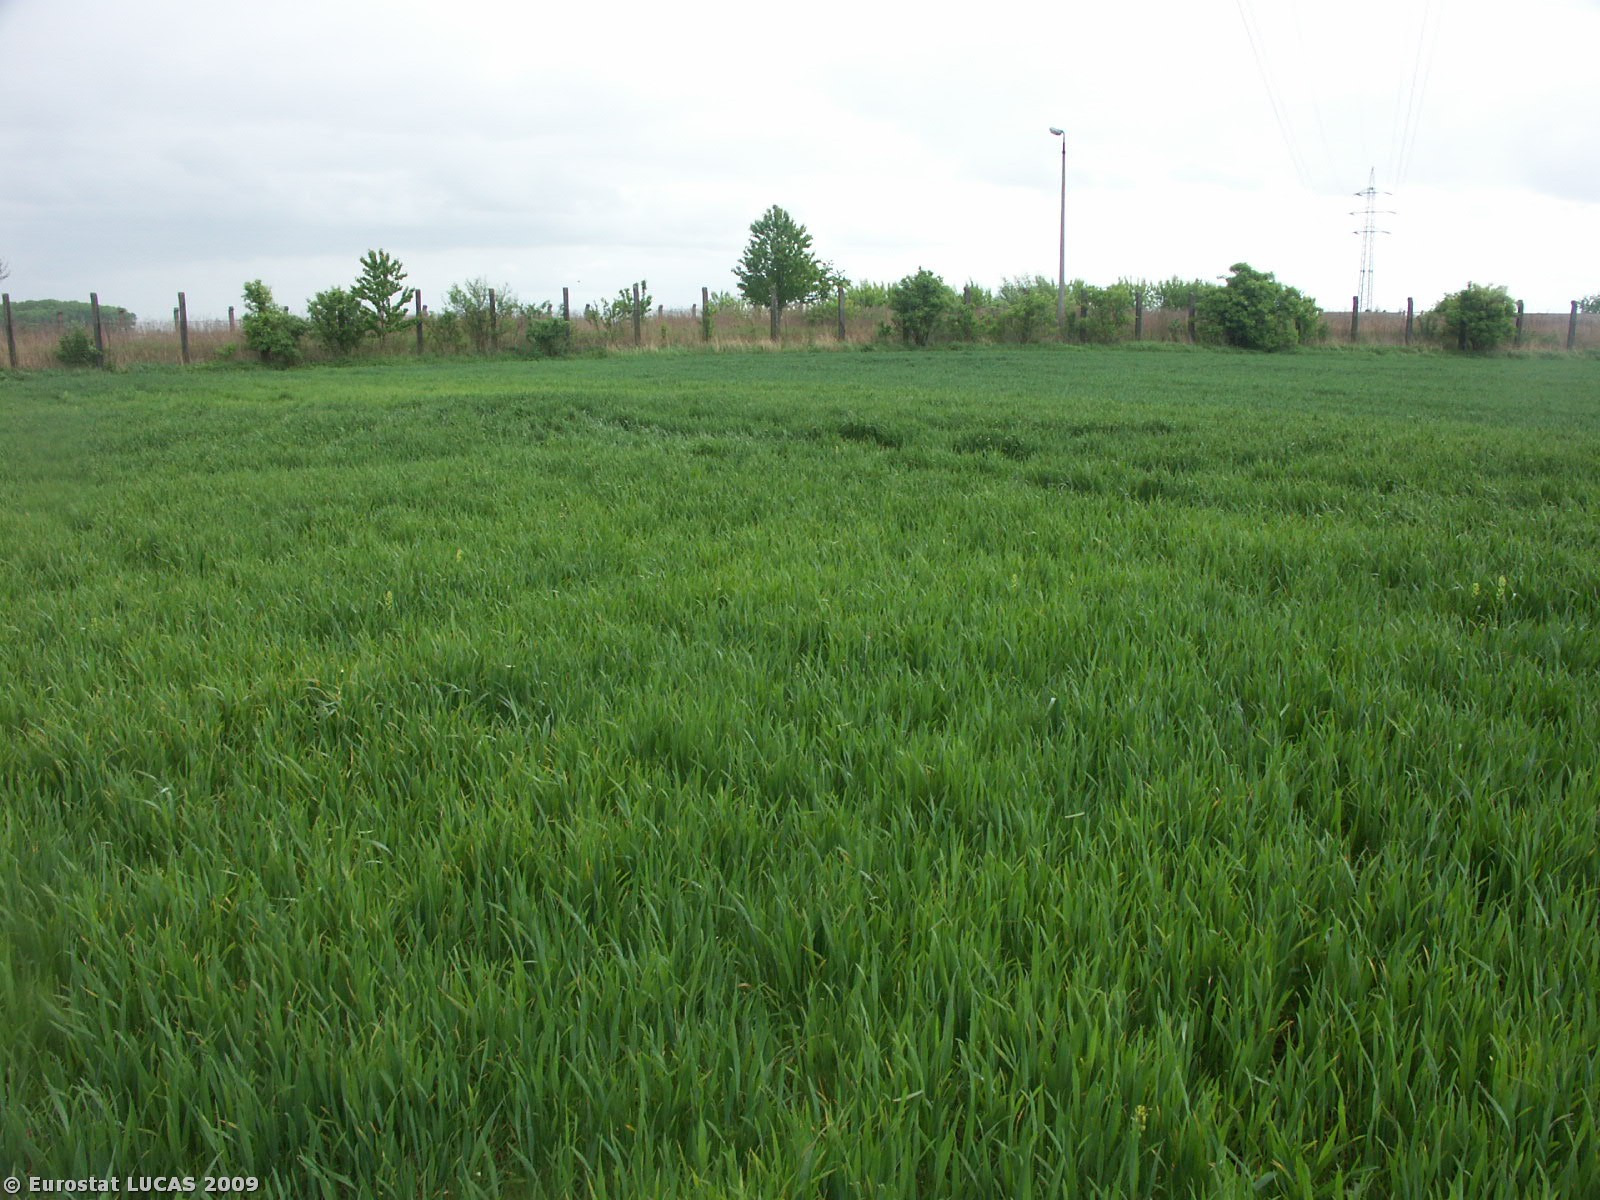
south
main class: Cropland
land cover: Common wheat
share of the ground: > 75 %
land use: Agriculture (excluding fallow land and kitchen gardens)
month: May
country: CZ
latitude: 49.7783
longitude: 17.1623
